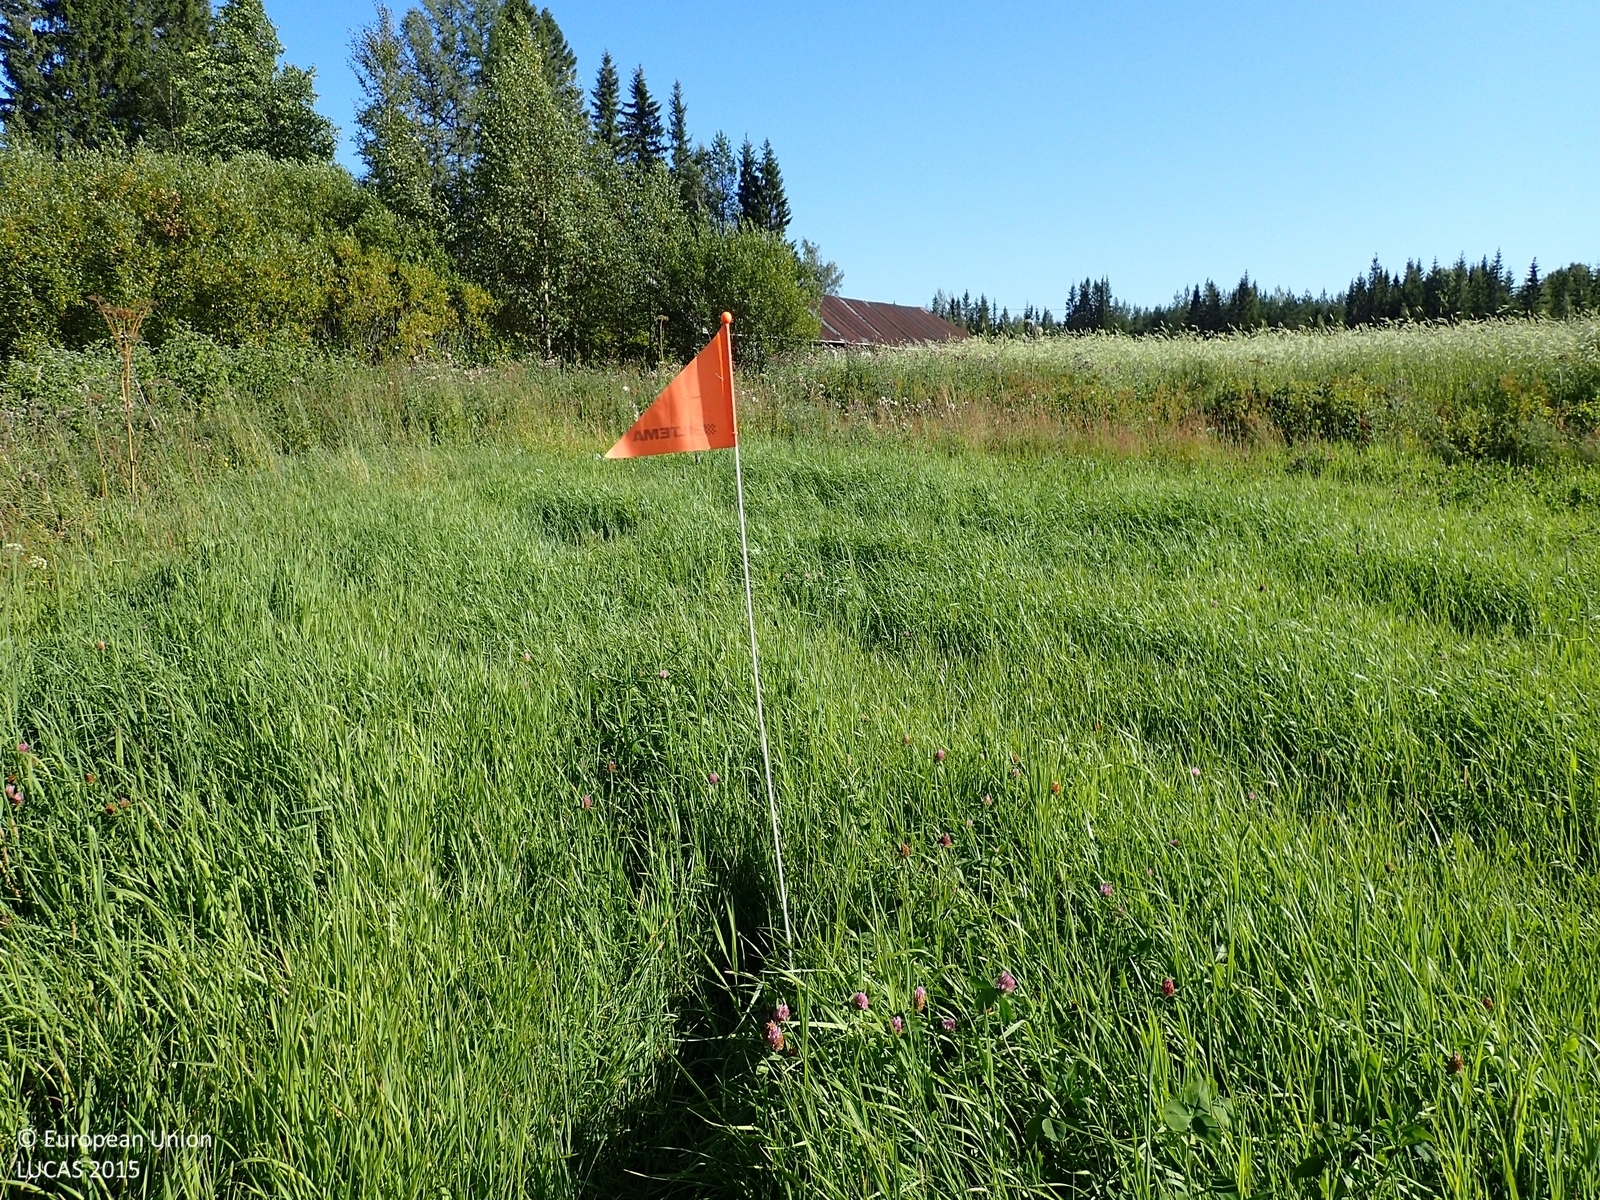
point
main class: Cropland
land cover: Temporary grasslands
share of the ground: > 75 %
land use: Agriculture (excluding fallow land and kitchen gardens)
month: August
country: FI
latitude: 62.3969
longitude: 21.8687
